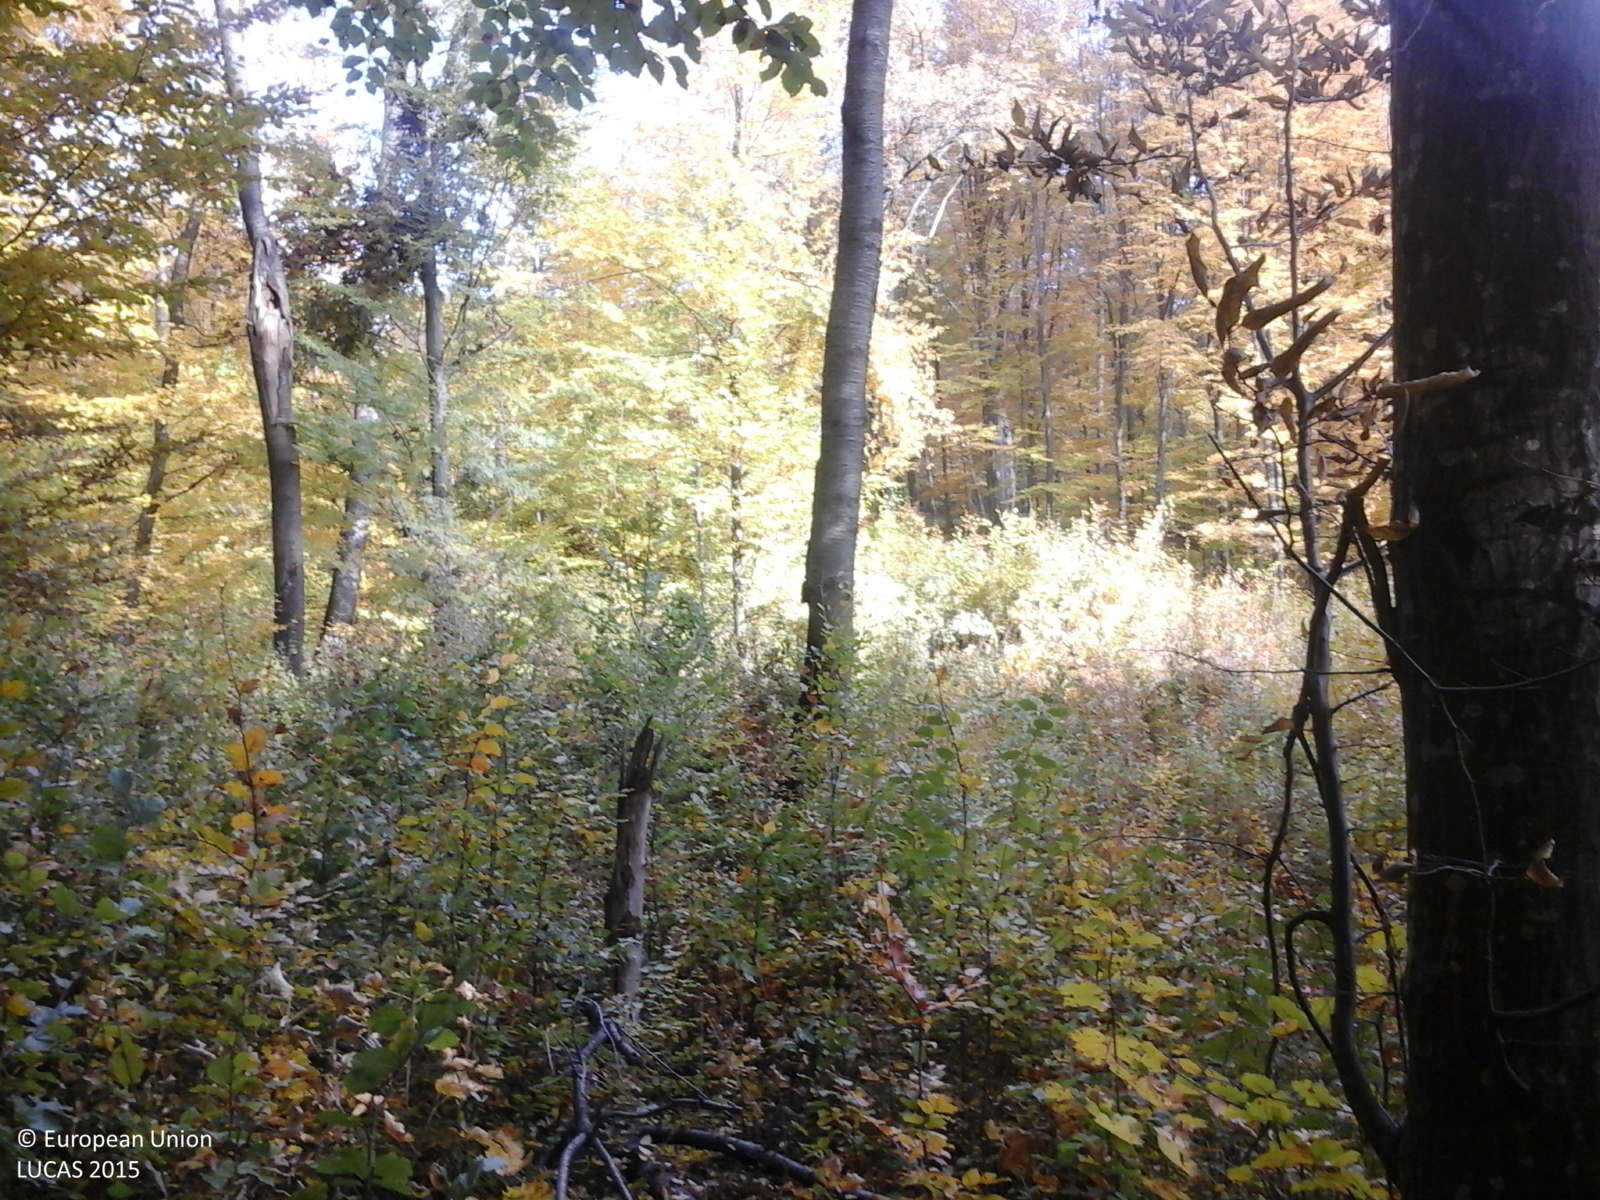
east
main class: Woodland
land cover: Broadleaved woodland
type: beech forest
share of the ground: > 75 %
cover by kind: broadleaved forest trees 100 %
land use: Forestry
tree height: > 5 m
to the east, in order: Broadleaved woodland; Tracks; Broadleaved woodland; Tracks; Broadleaved woodland
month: October
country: RO
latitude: 45.5304
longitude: 26.7660
